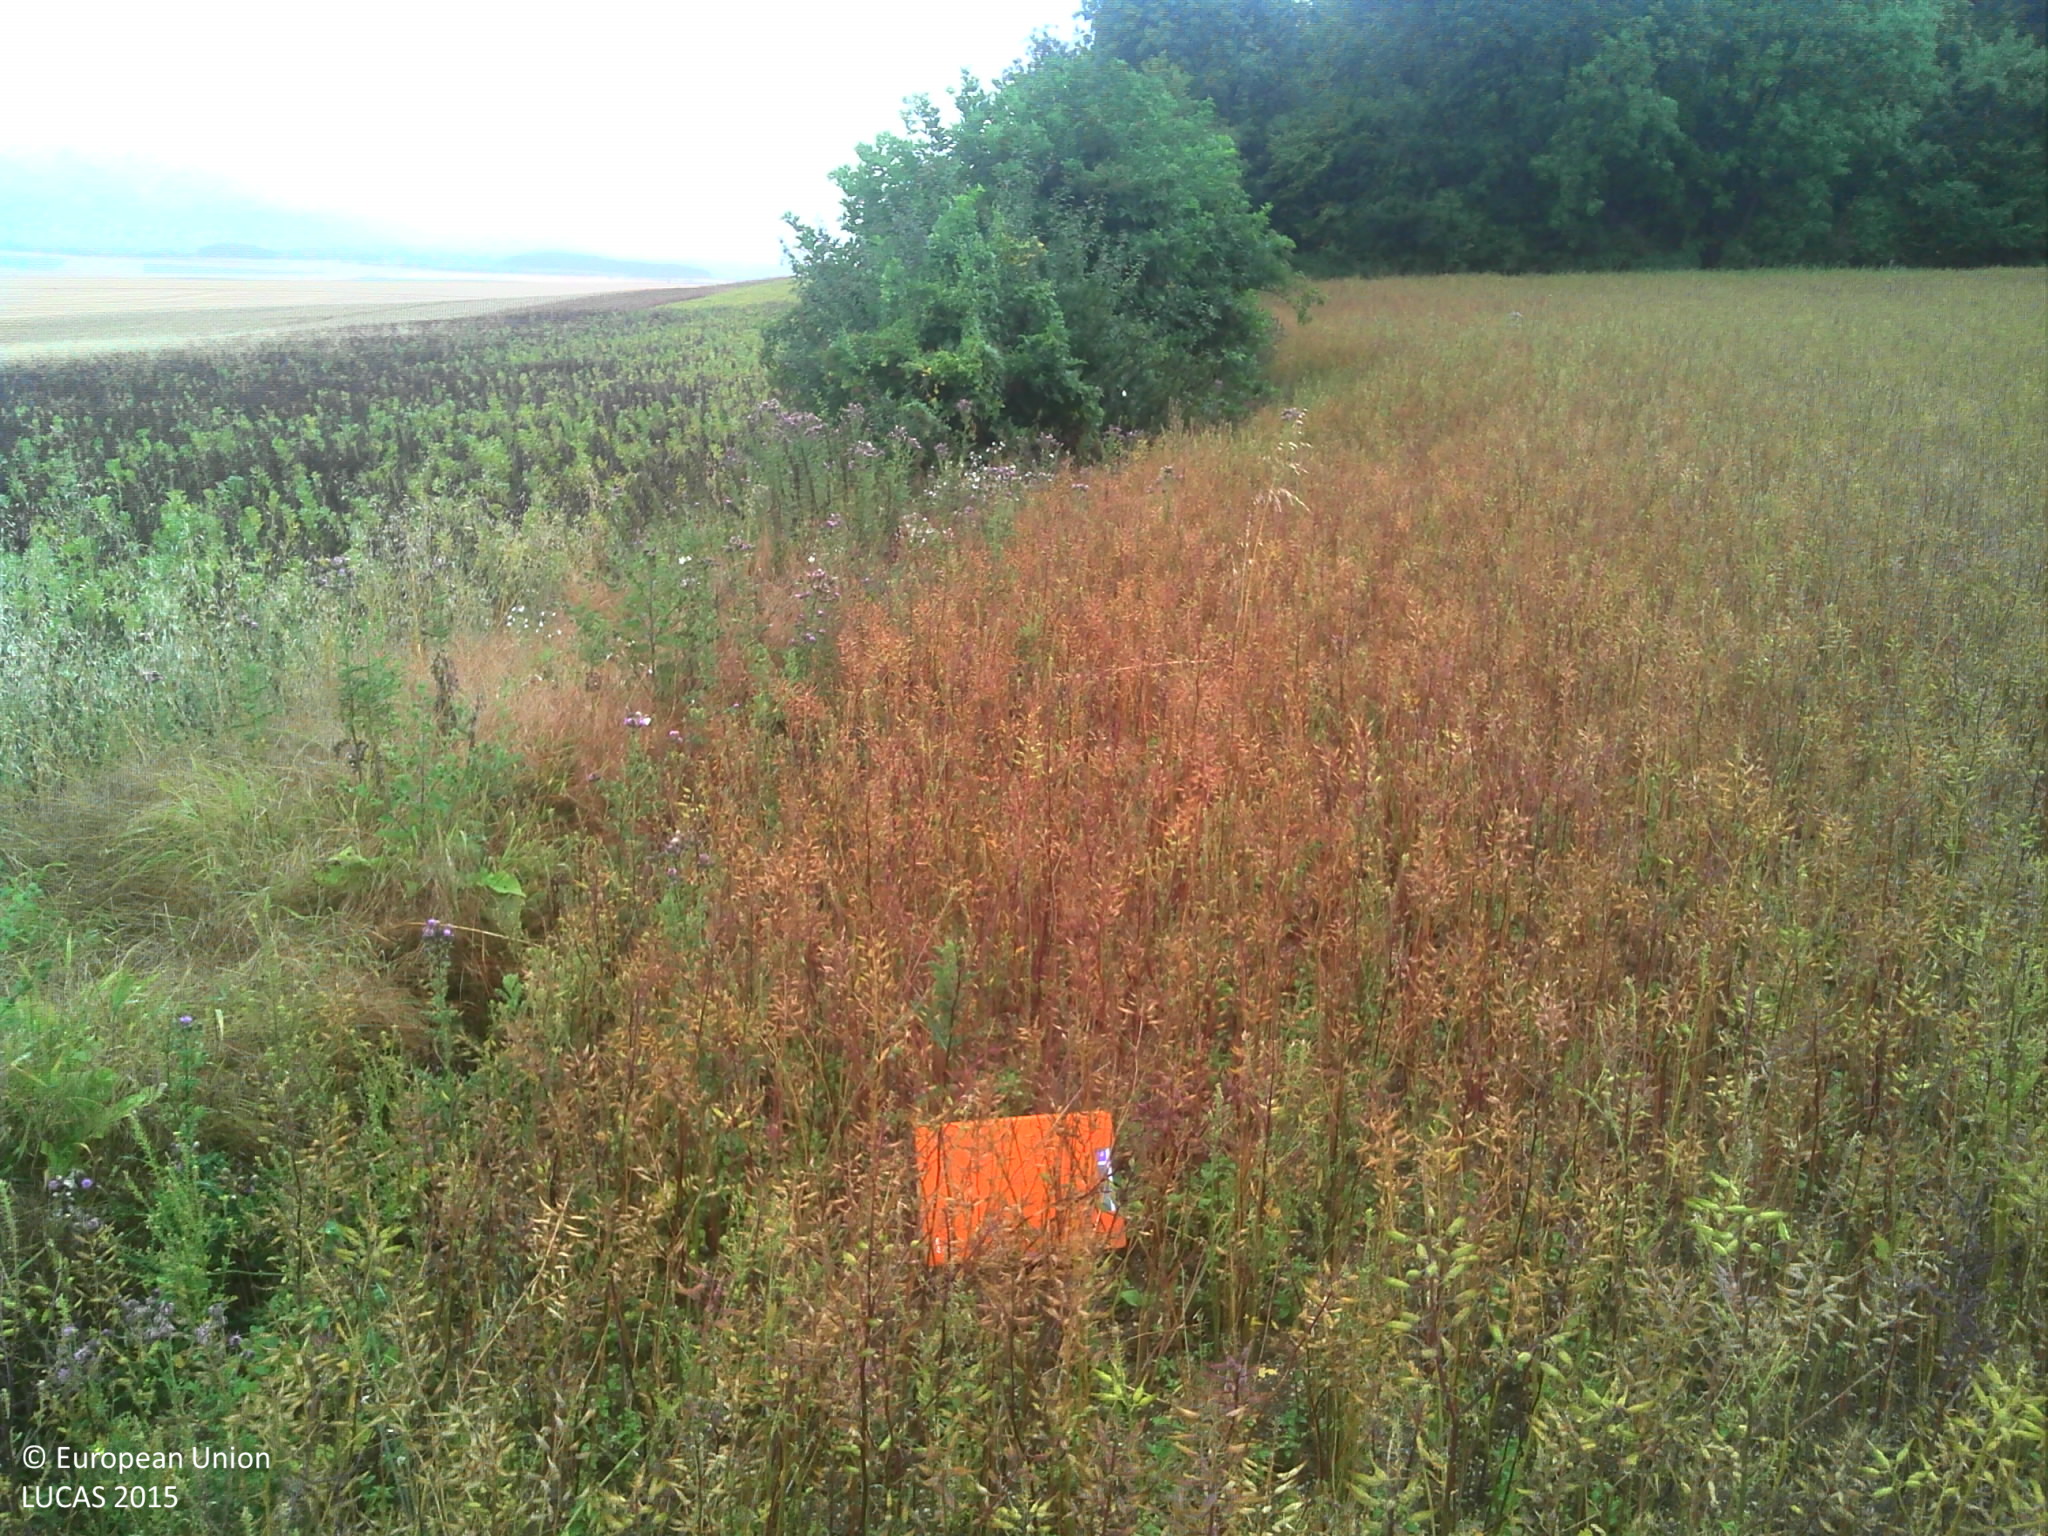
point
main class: Cropland
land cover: Other fibre and oleaginous crops
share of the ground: 50 - 75 %
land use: Agriculture (excluding fallow land and kitchen gardens)
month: July
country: FR
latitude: 49.6651
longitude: 3.6617
